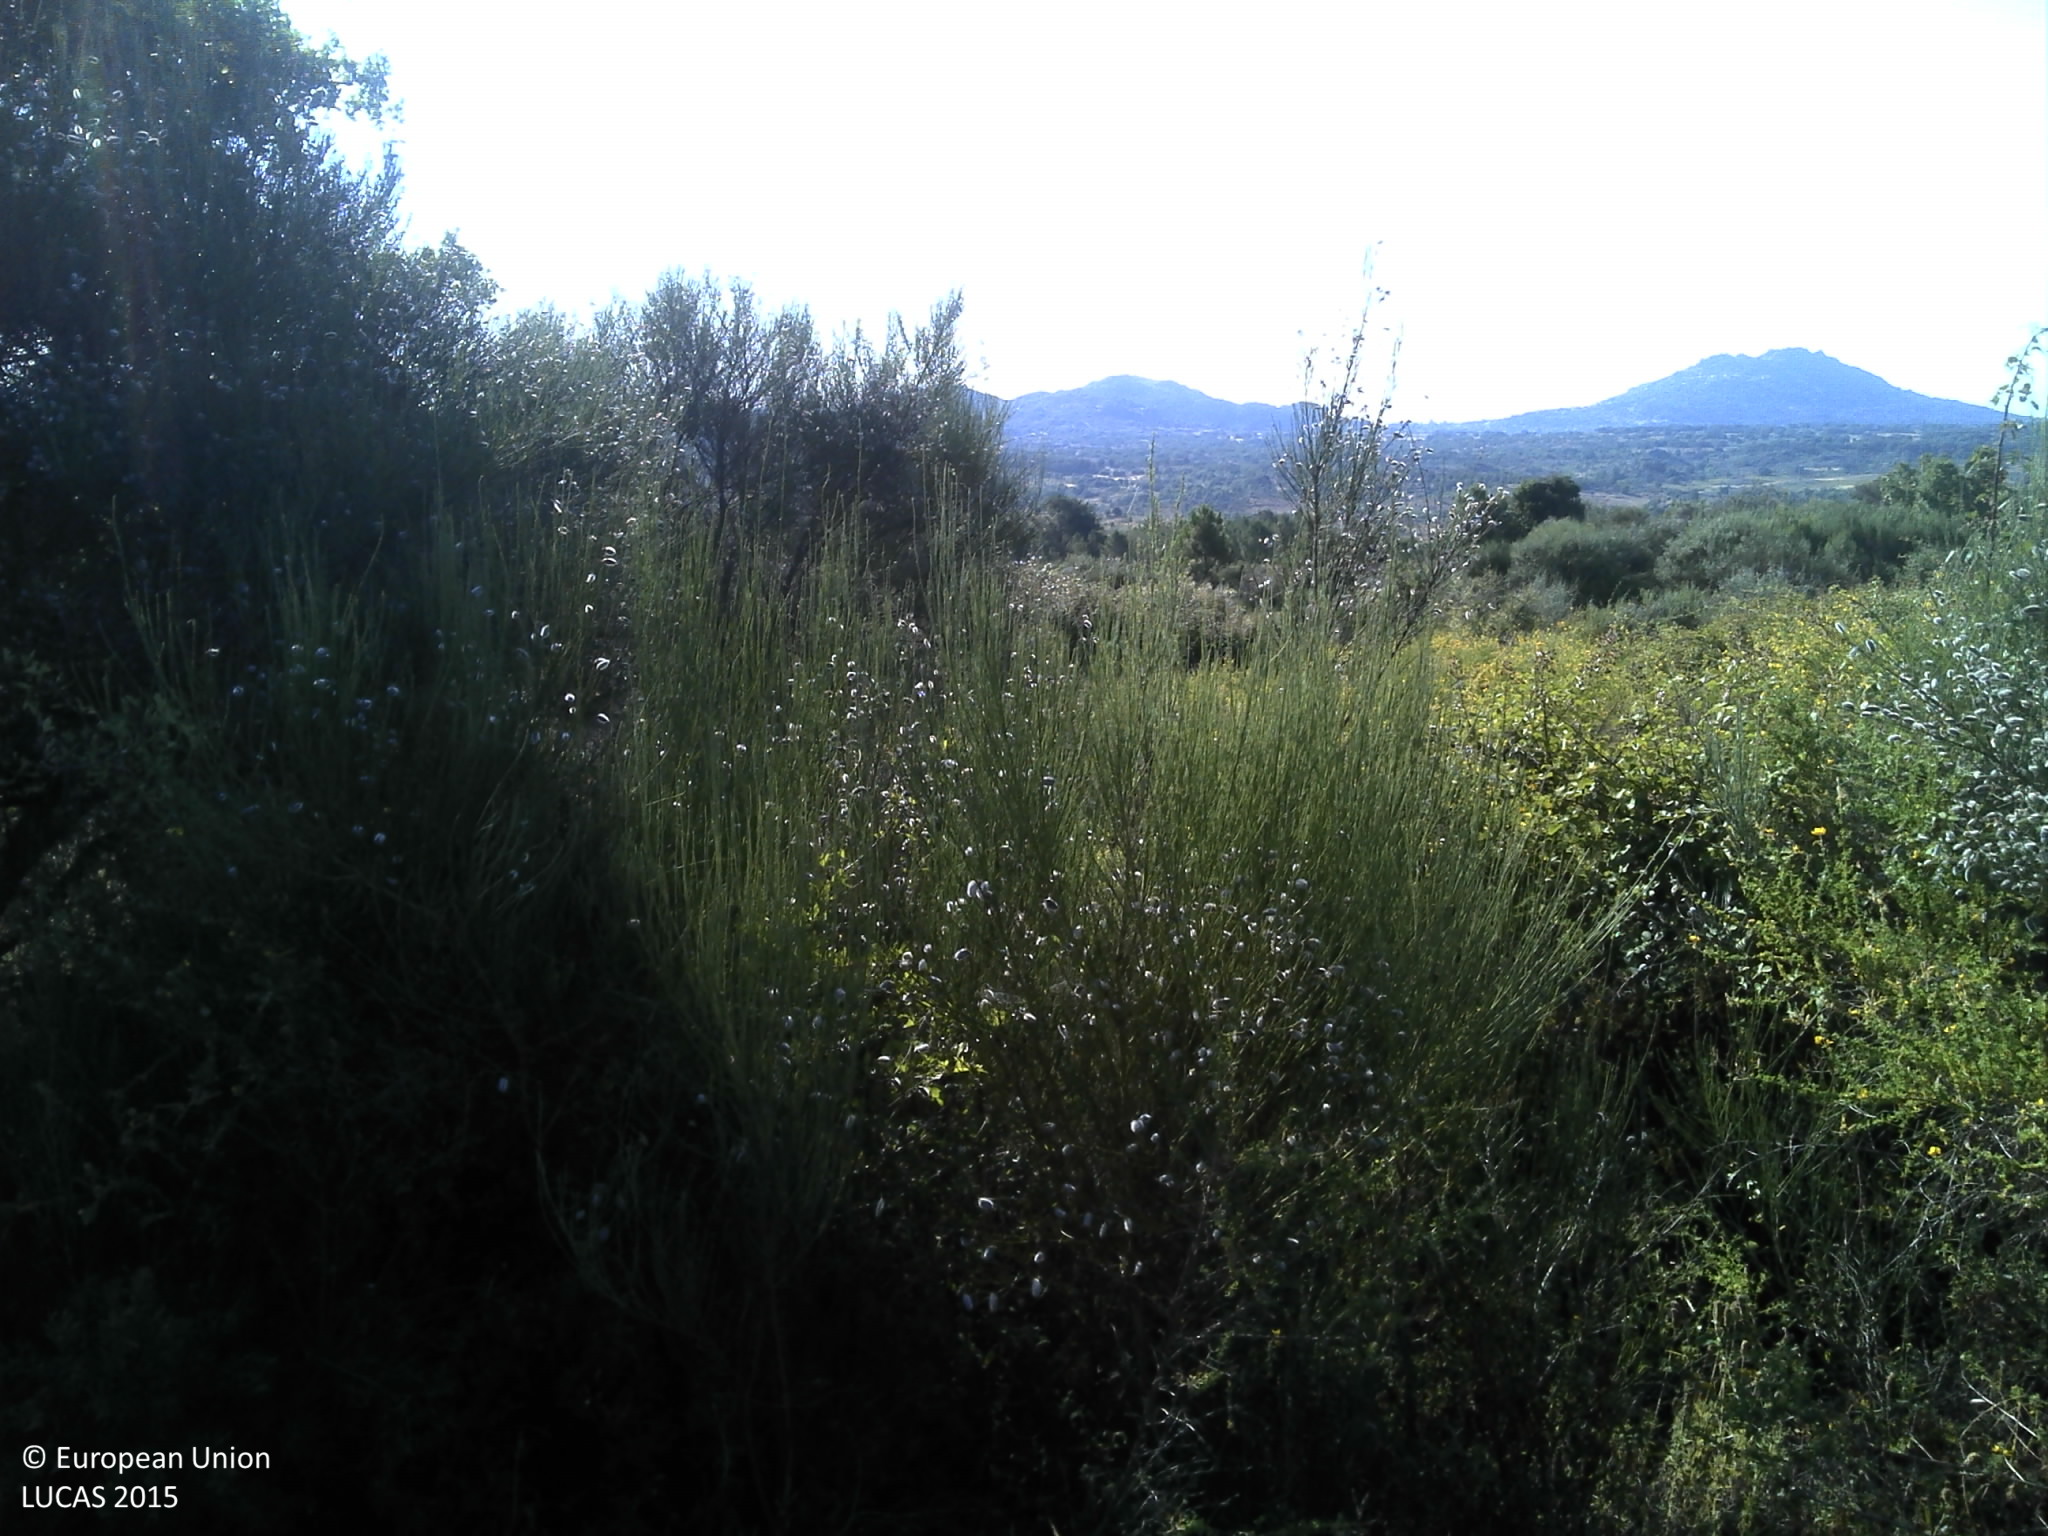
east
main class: Shrubland
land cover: Shrubland with sparse tree cover
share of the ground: 50 - 75 %
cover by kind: shrubs 70 %, herbaceous plants 15 %, coniferous forest trees 5 %, unconsolidated bare surface 5 %
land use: Semi-natural and natural areas not in use
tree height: < 5 m
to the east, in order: Shrubland with sparse tree cover; Tracks; Shrubland without tree cover
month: June
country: PT
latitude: 40.0849
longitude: -7.1836
